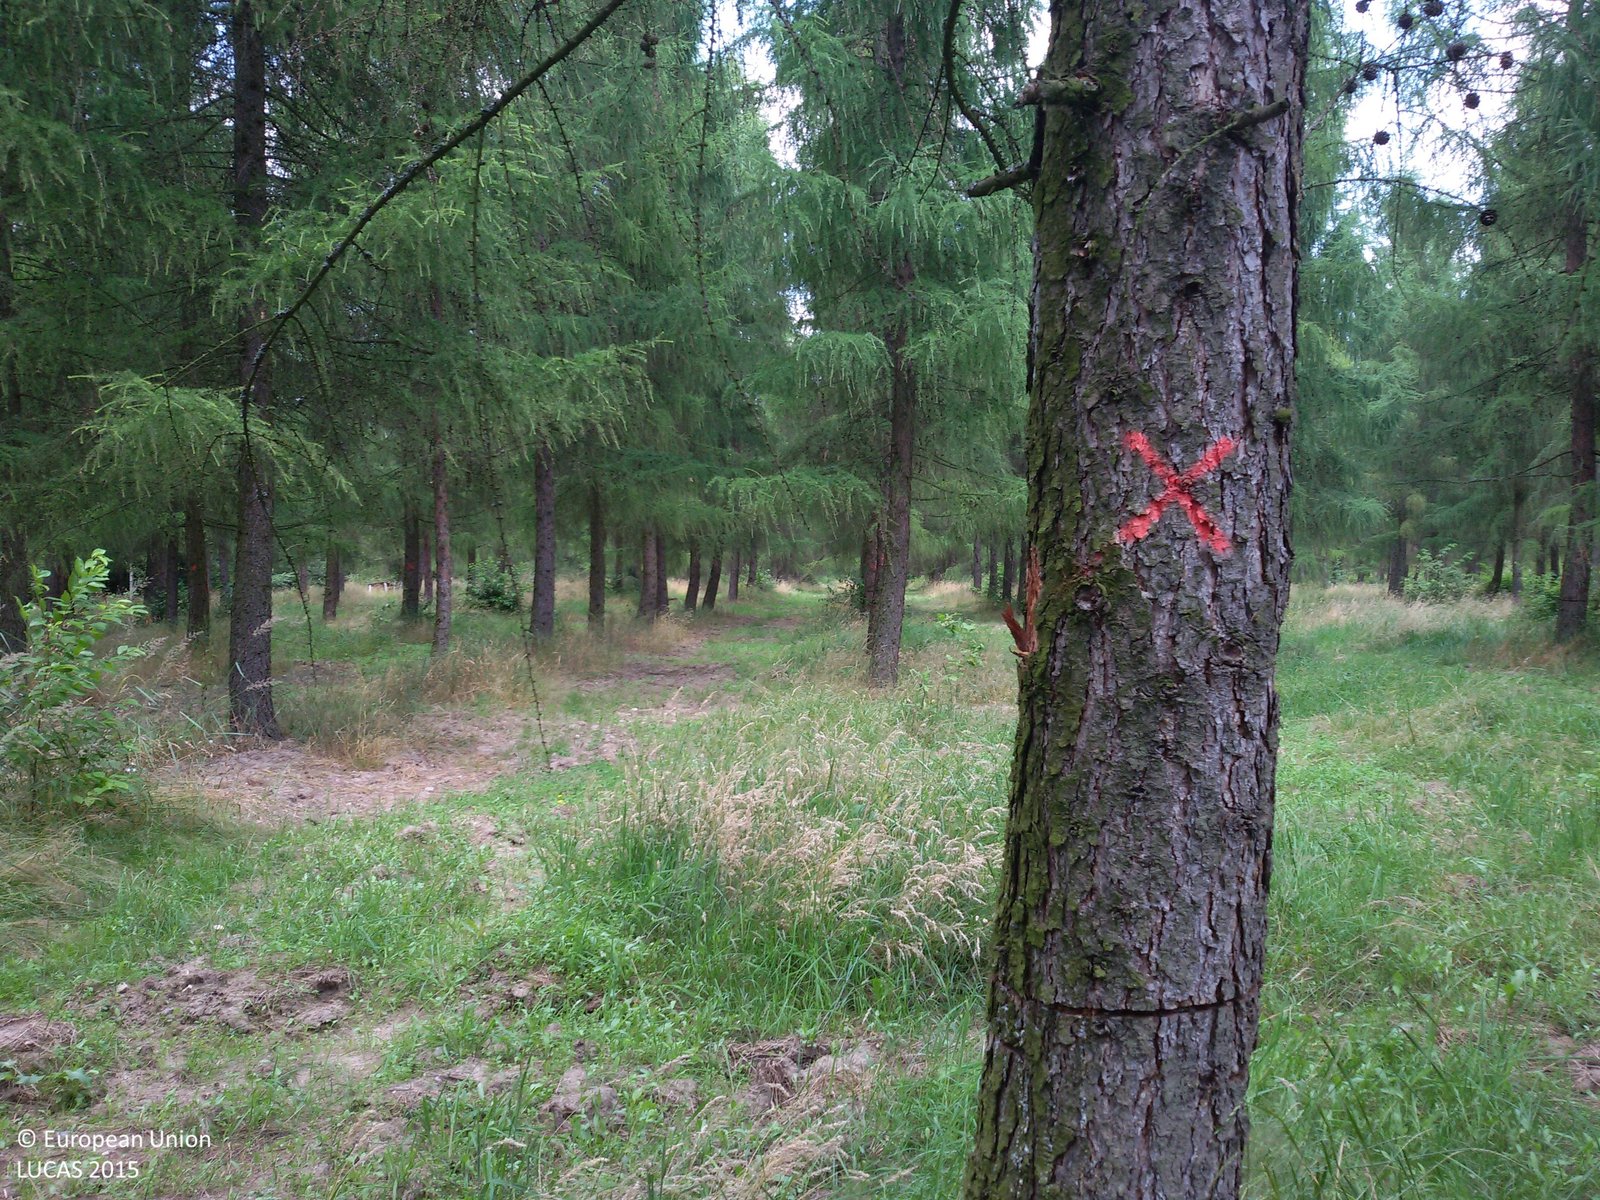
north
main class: Woodland
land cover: Other coniferous woodland
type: hemiboreal forest and nemoral coniferous forest and mixed broadleaved-coniferous forest
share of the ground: 50 - 75 %
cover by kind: coniferous forest trees 70 %, herbaceous plants 20 %, shrubs 5 %, unconsolidated bare surface 5 %
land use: Forestry
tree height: > 5 m
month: July
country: PL
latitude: 51.6972
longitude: 19.8260
